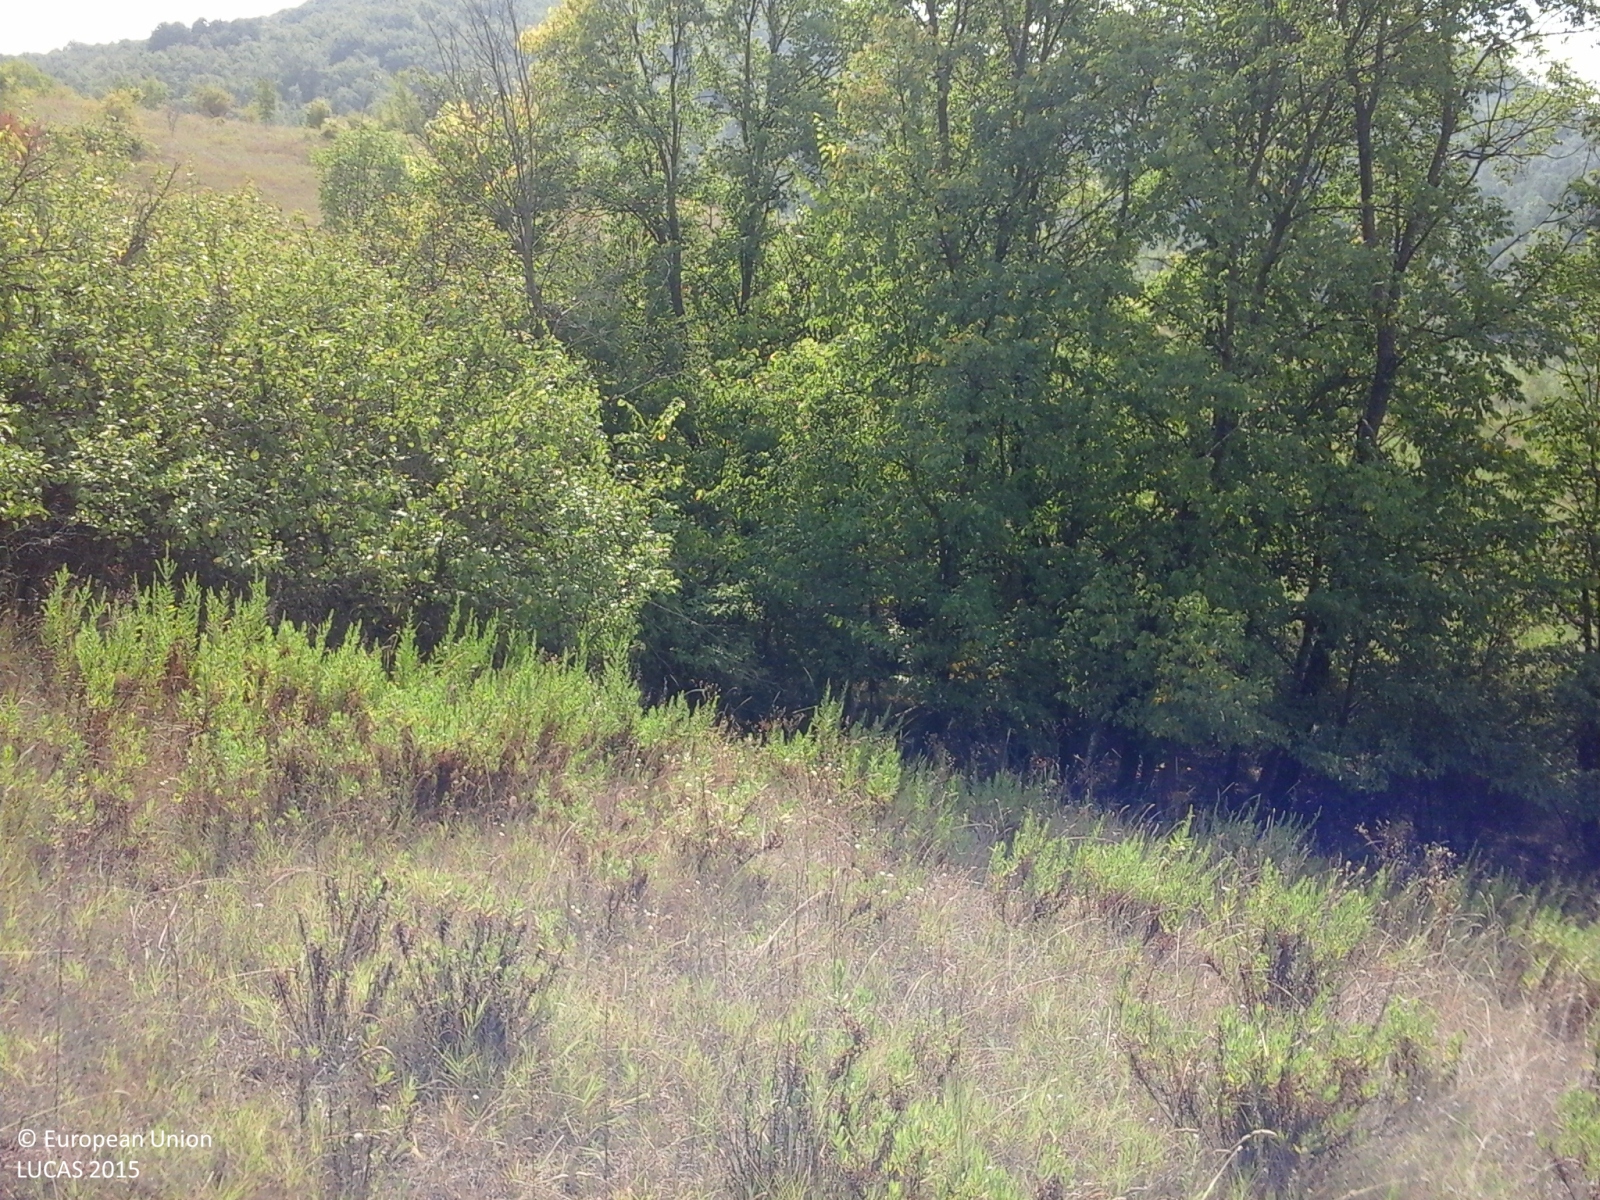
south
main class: Grassland
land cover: Grassland without tree/shrub cover
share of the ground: > 75 %
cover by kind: herbaceous plants 100 %
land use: Semi-natural and natural areas not in use
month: August
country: IT
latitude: 44.8877
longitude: 9.1029
